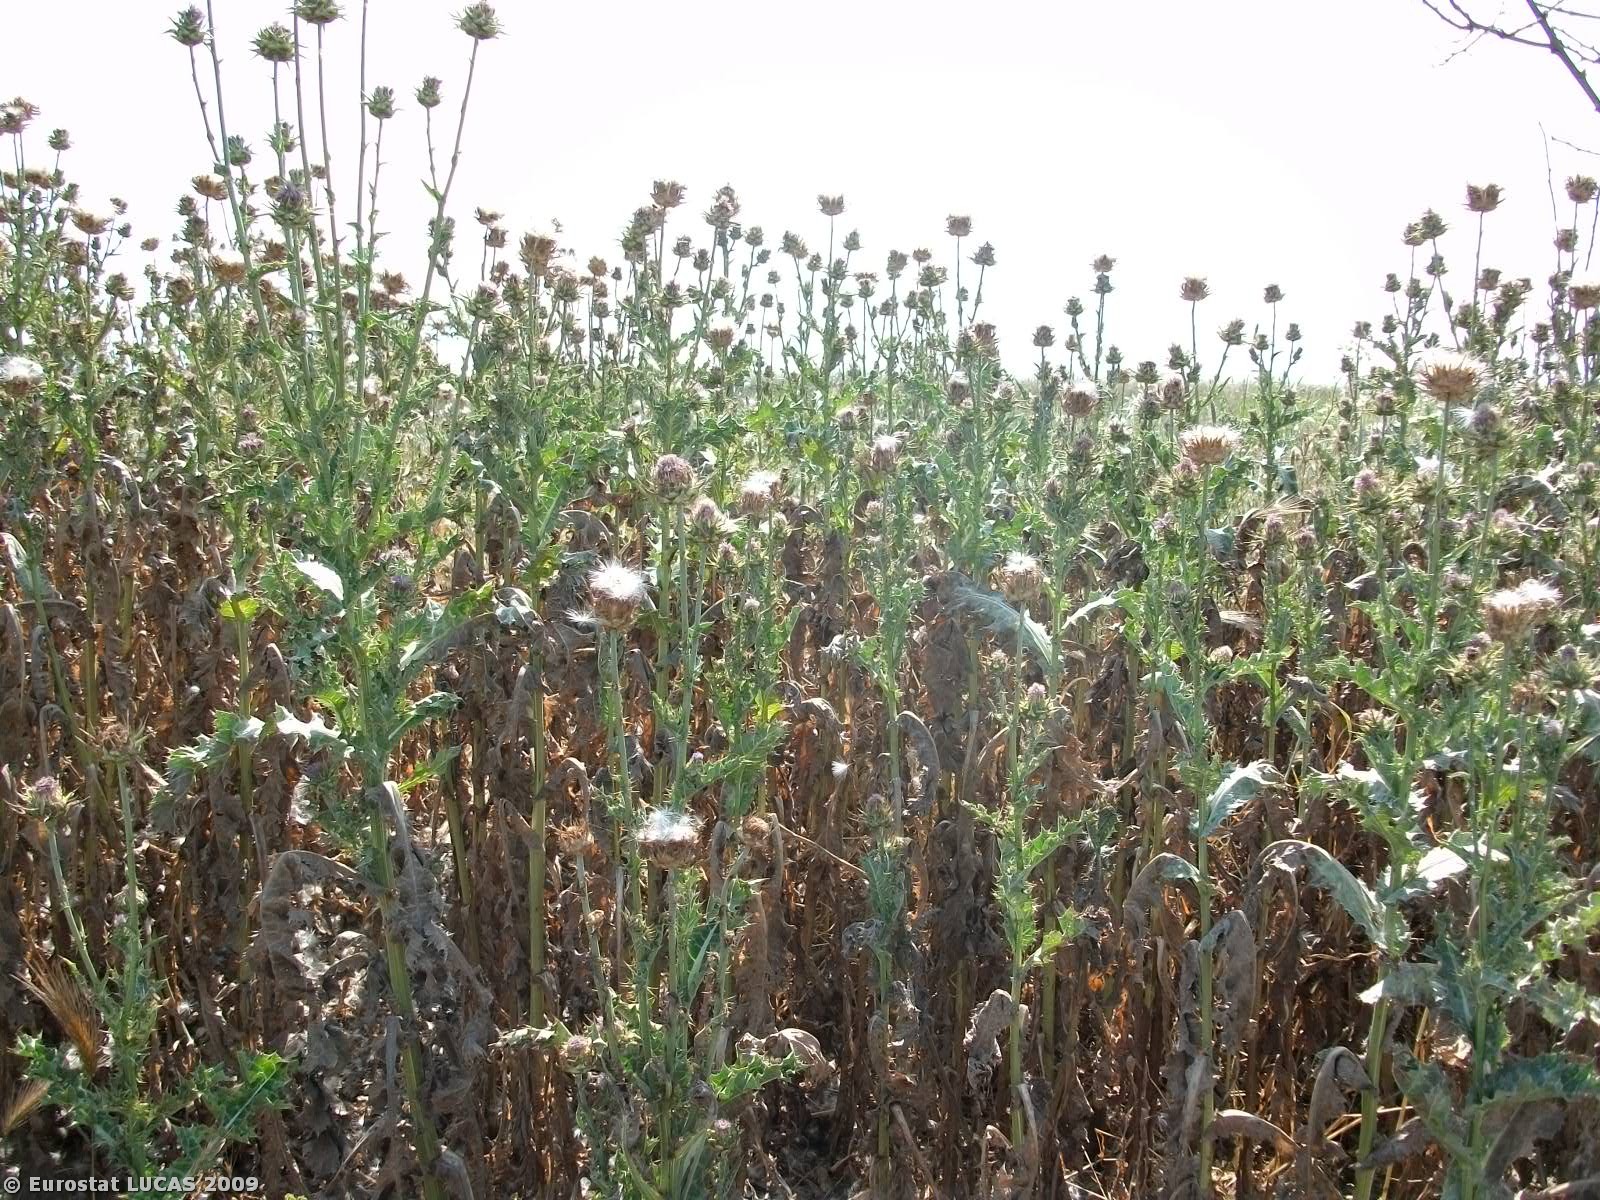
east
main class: Grassland
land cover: Spontaneously vegetated surfaces
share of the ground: > 75 %
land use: Unused
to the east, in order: Spontaneously vegetated surfaces; Paved roads, cycling and walking lanes; Grass margins; Ditches and canals; Grass margins; Paved roads, cycling and walking lanes; Grass margins; Grassland without tree/shrub cover; Paved roads, cycling and walking lanes; Grassland with sparse tree/shrub cover; Ditches and canals; Grassland with sparse tree/shrub cover; Durum wheat
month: May
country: GR
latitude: 39.7312
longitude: 22.4170
